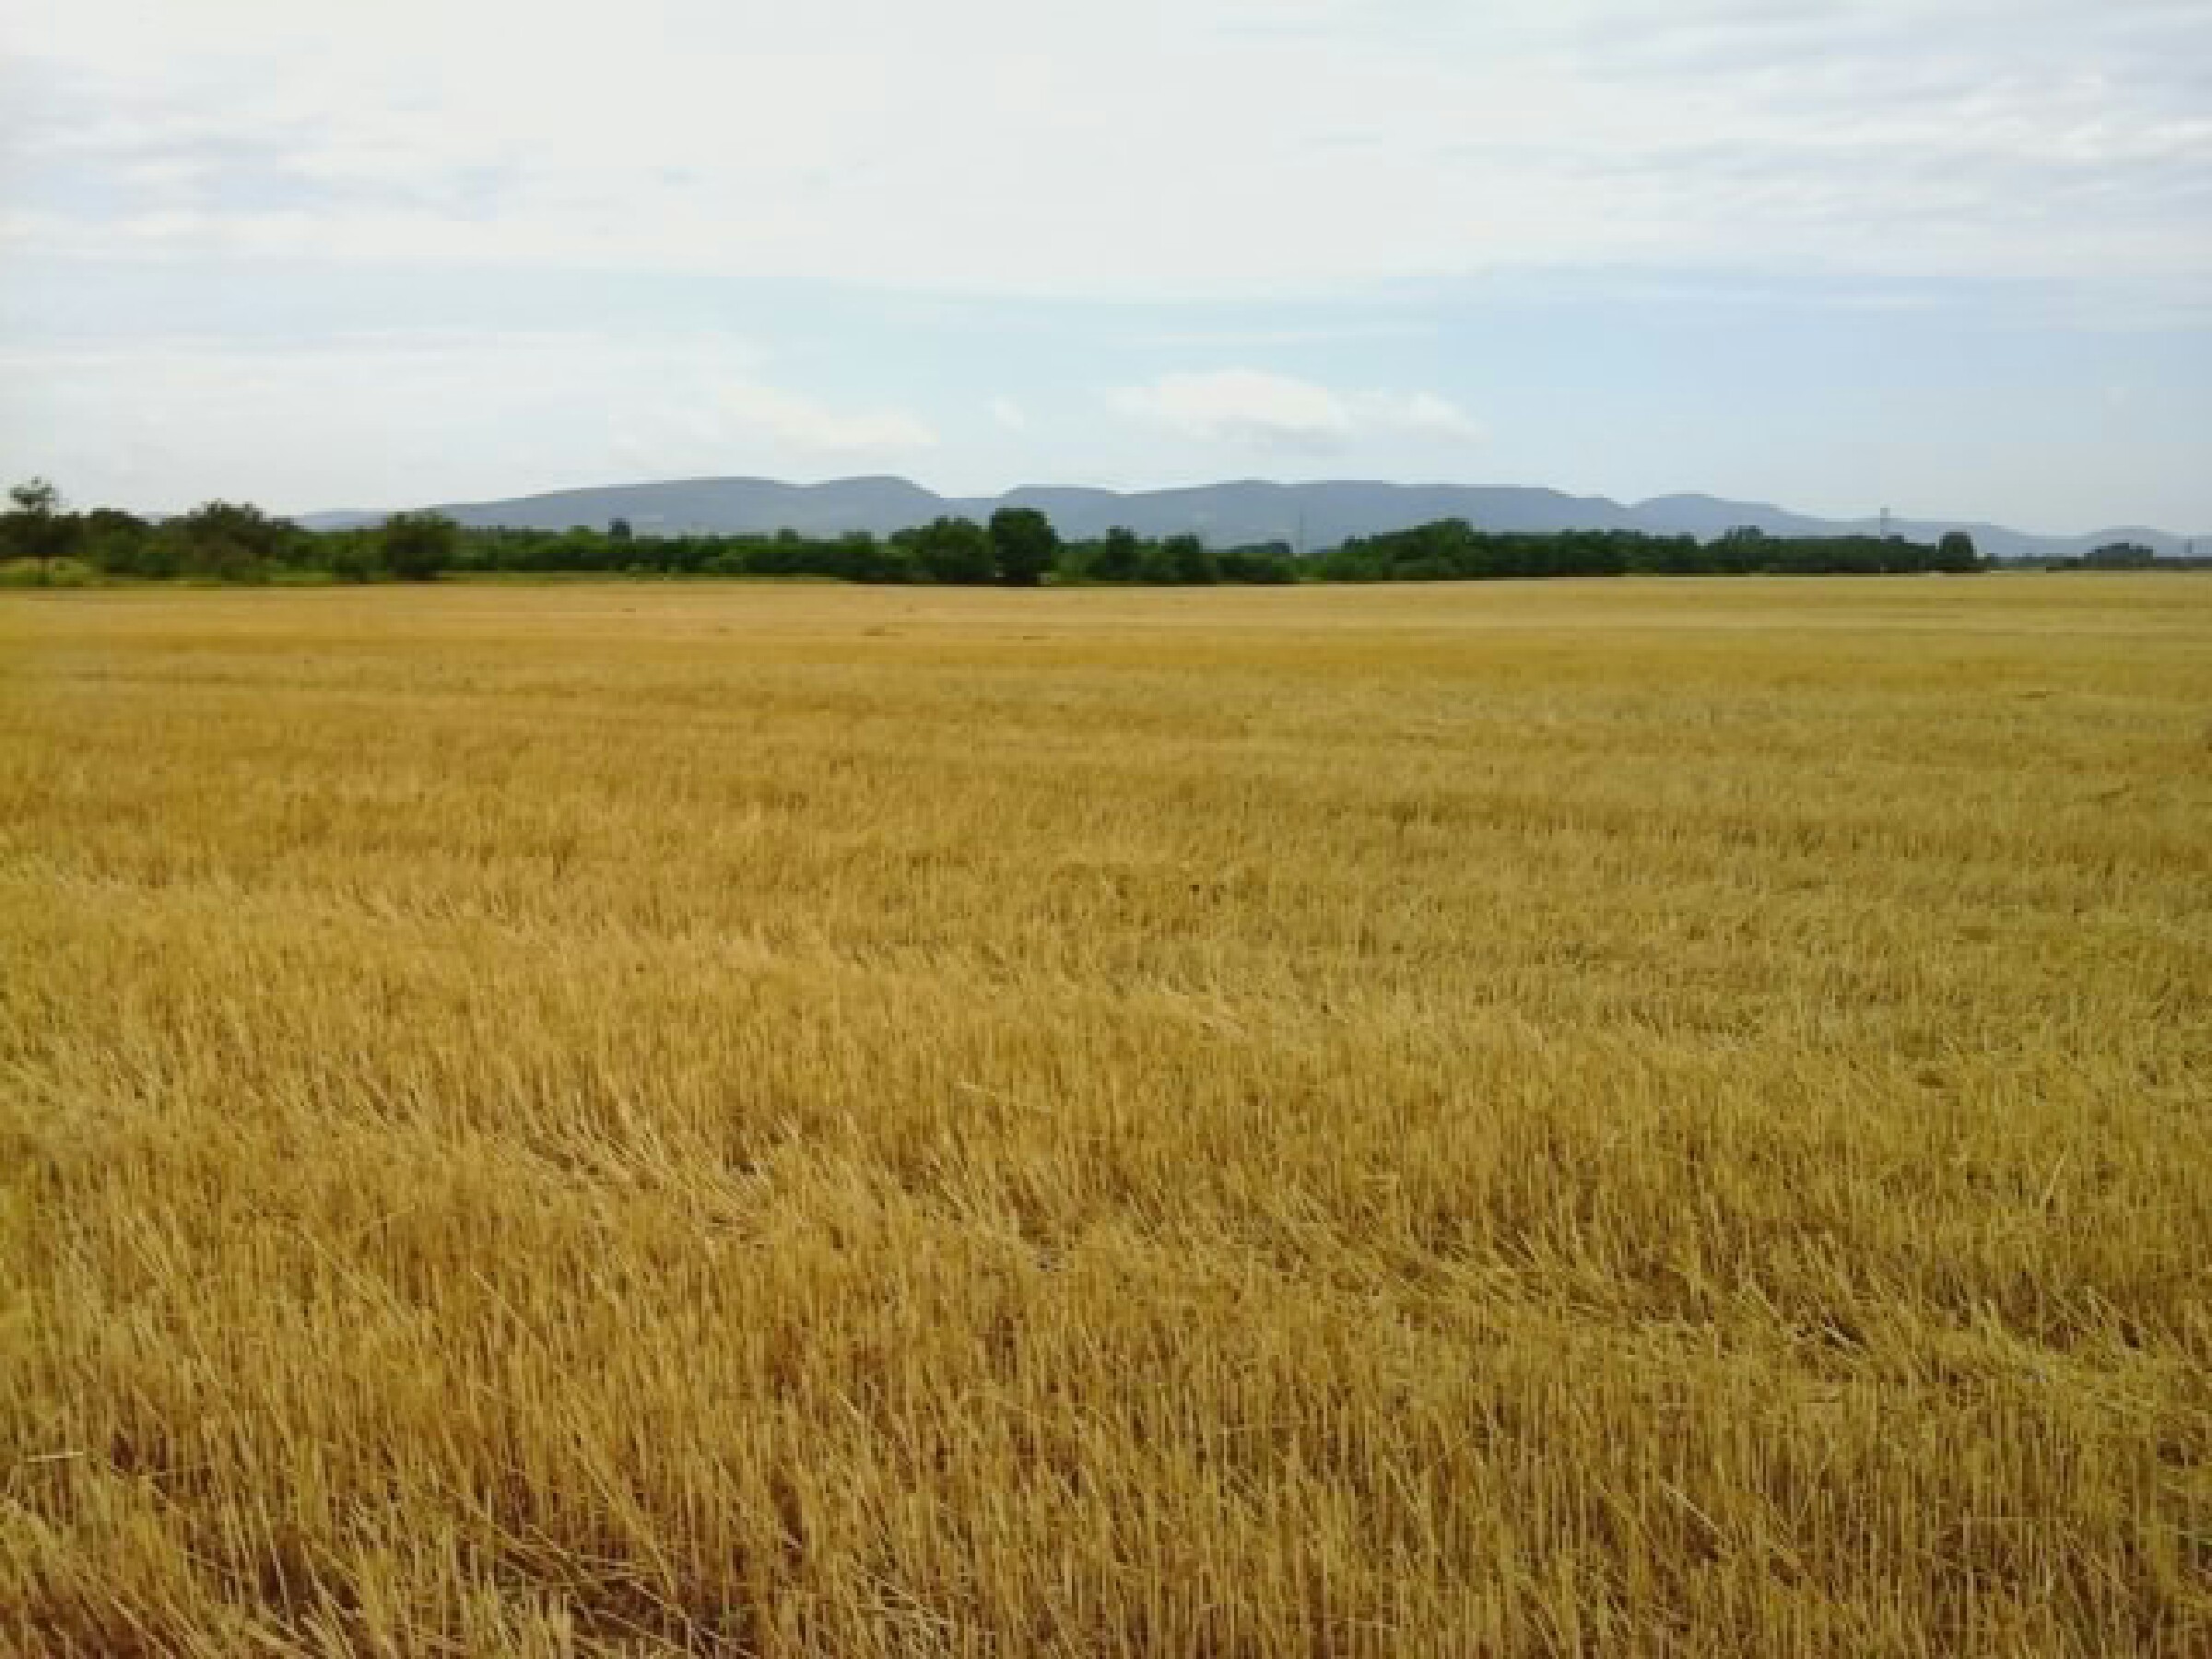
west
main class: Cropland
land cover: Common wheat
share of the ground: > 75 %
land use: Agriculture (excluding fallow land and kitchen gardens)
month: July
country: HU
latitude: 47.7133
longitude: 19.1767
